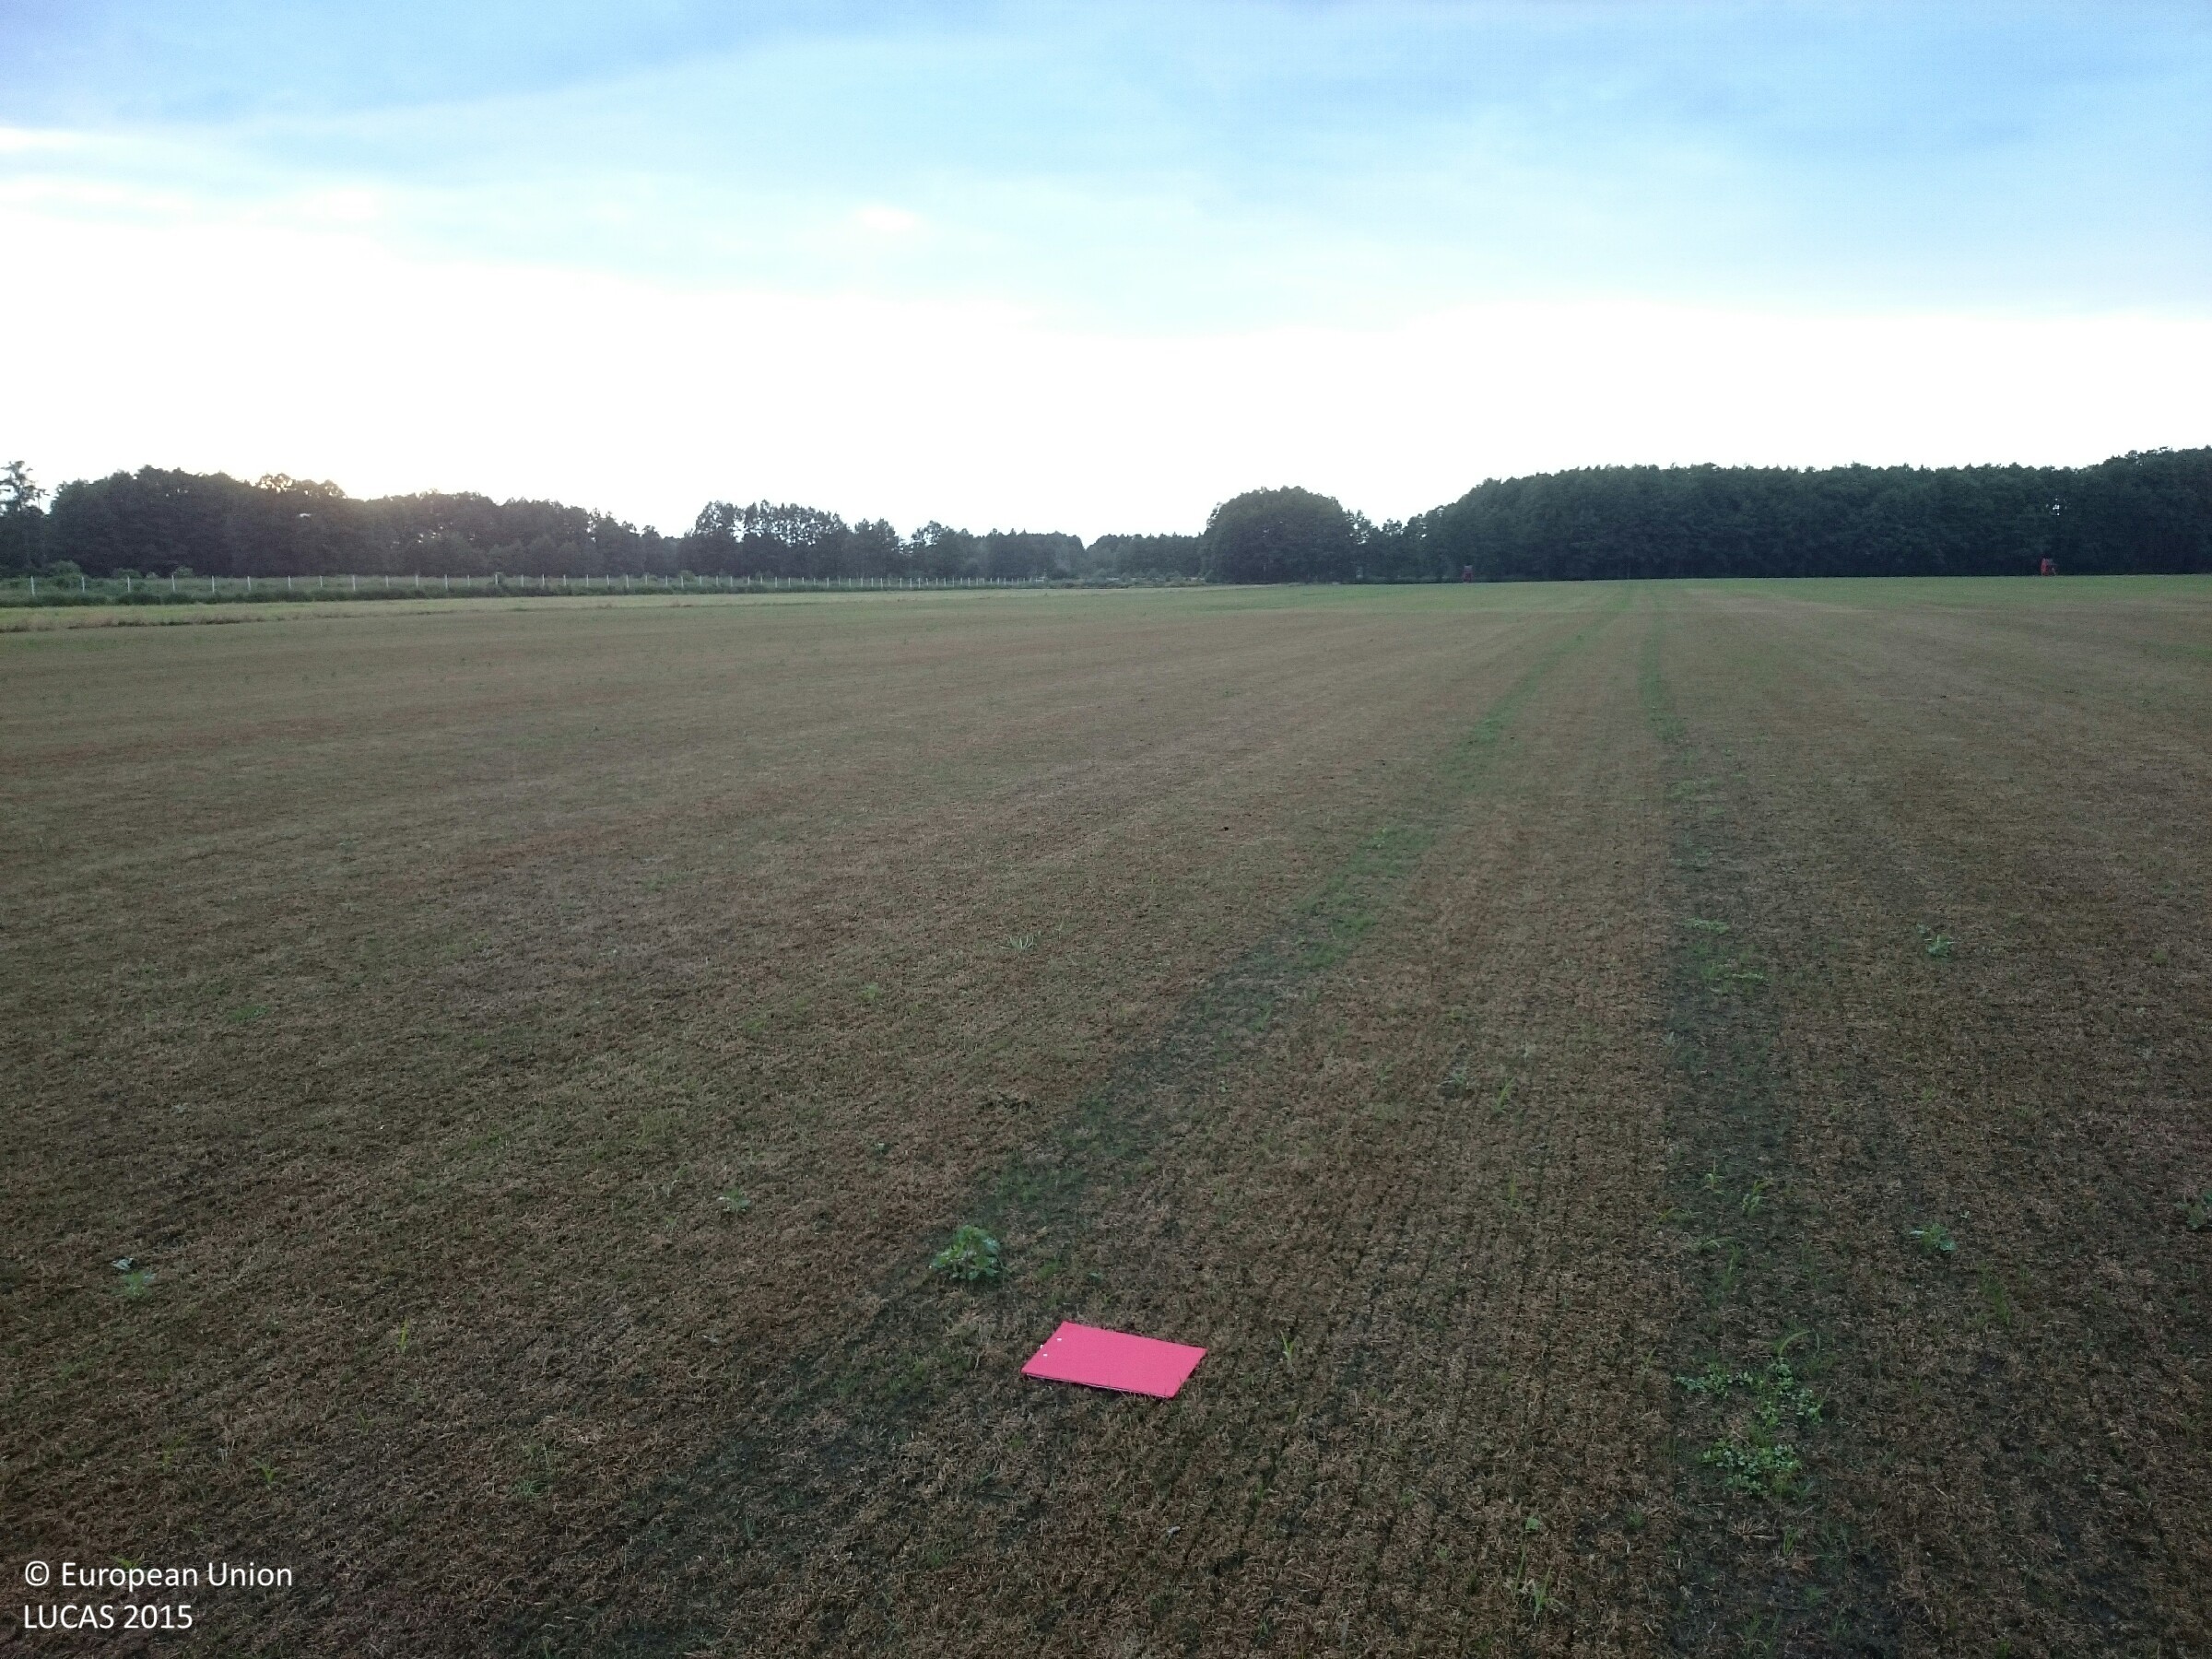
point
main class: Grassland
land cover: Grassland without tree/shrub cover
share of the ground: > 75 %
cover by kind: herbaceous plants 100 %
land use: Agriculture (excluding fallow land and kitchen gardens)
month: June
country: PL
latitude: 52.7476
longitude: 15.6485
